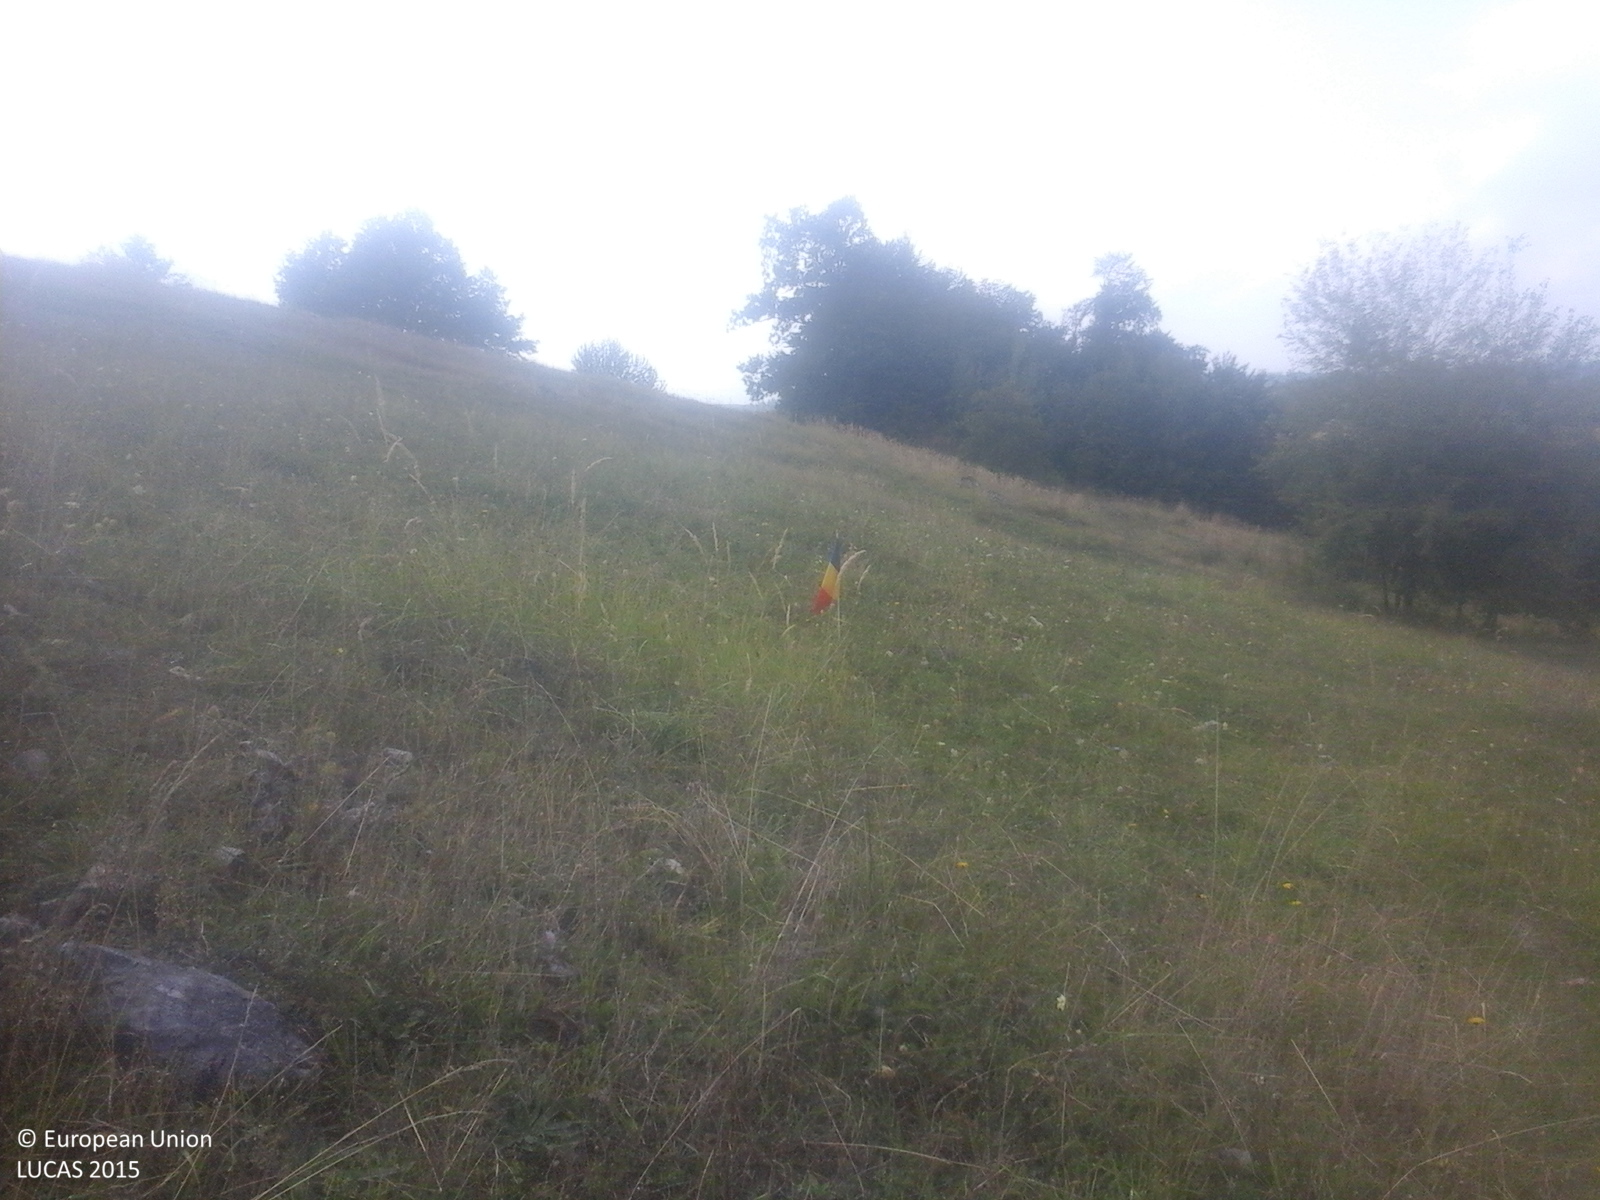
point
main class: Grassland
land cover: Grassland without tree/shrub cover
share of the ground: > 75 %
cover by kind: herbaceous plants 100 %
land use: Agriculture (excluding fallow land and kitchen gardens)
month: September
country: RO
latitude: 46.8476
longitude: 22.3921
